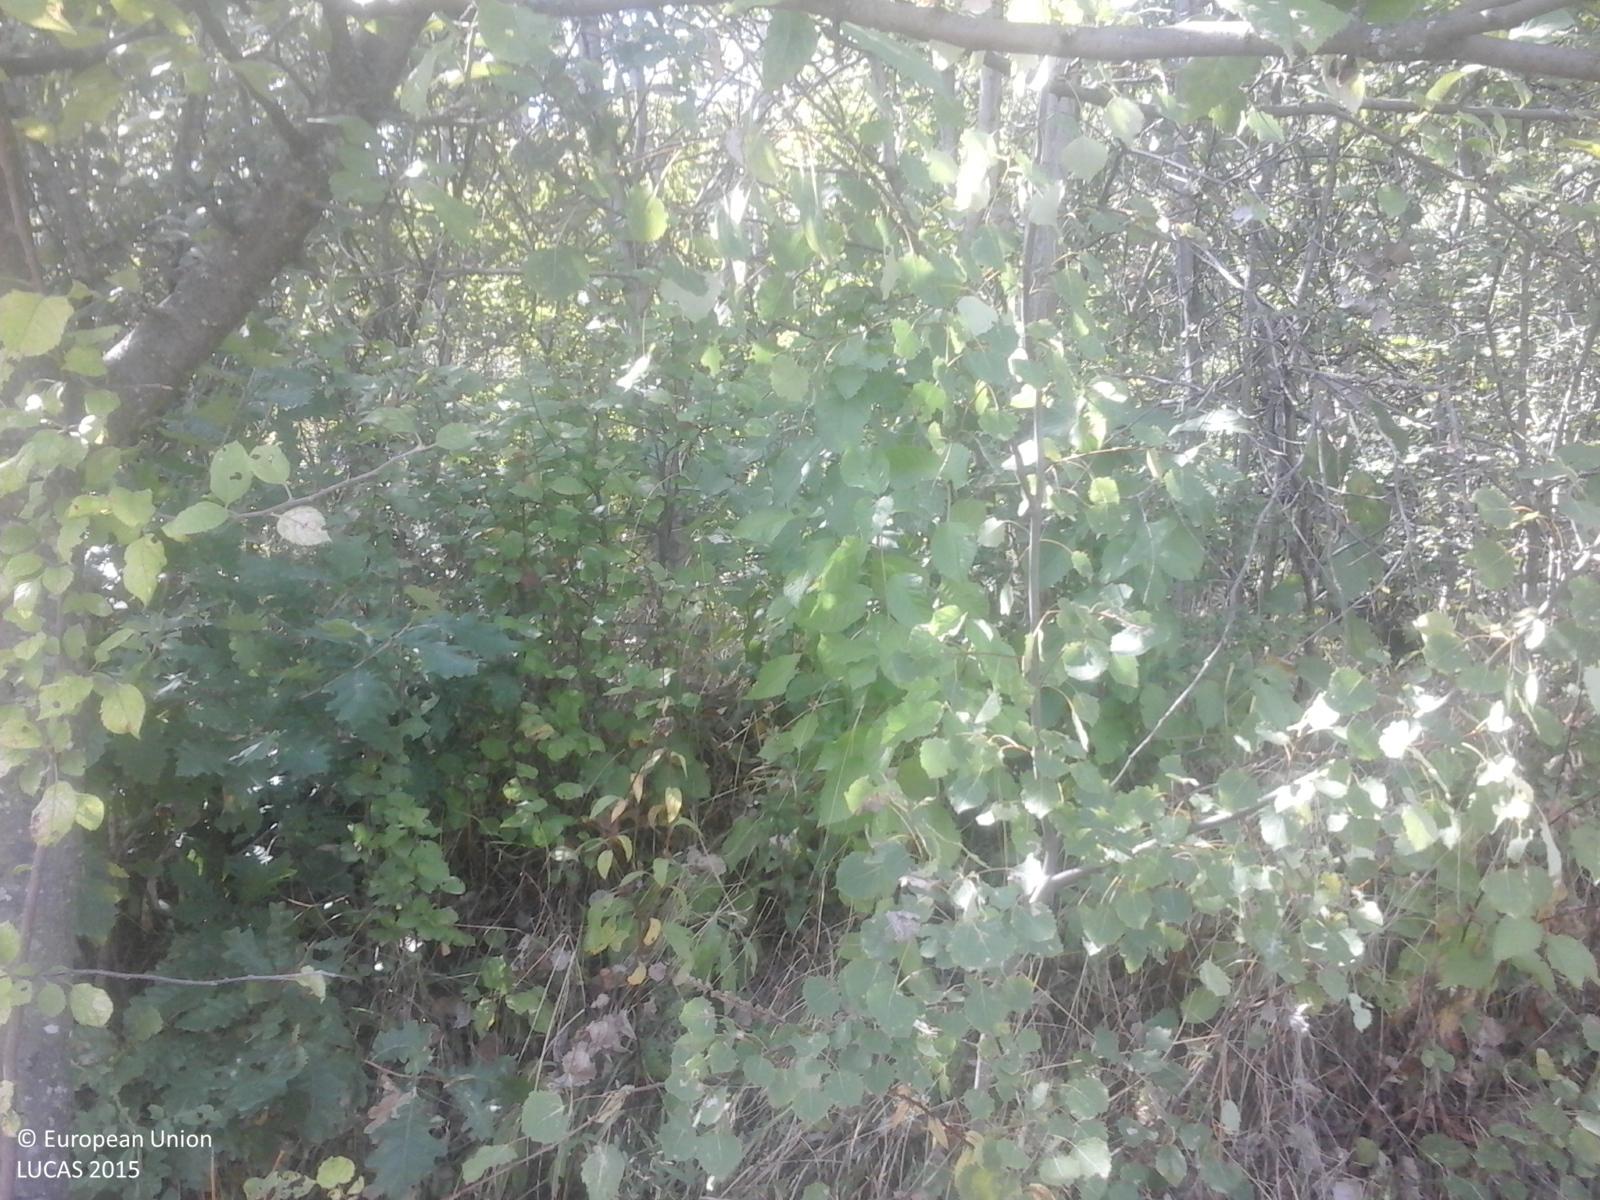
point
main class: Woodland
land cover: Broadleaved woodland
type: acidophilous oak and oak-birch forest
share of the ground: > 75 %
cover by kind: broadleaved forest trees 100 %
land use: Forestry
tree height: > 5 m
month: September
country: RO
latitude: 46.9108
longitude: 23.2344
